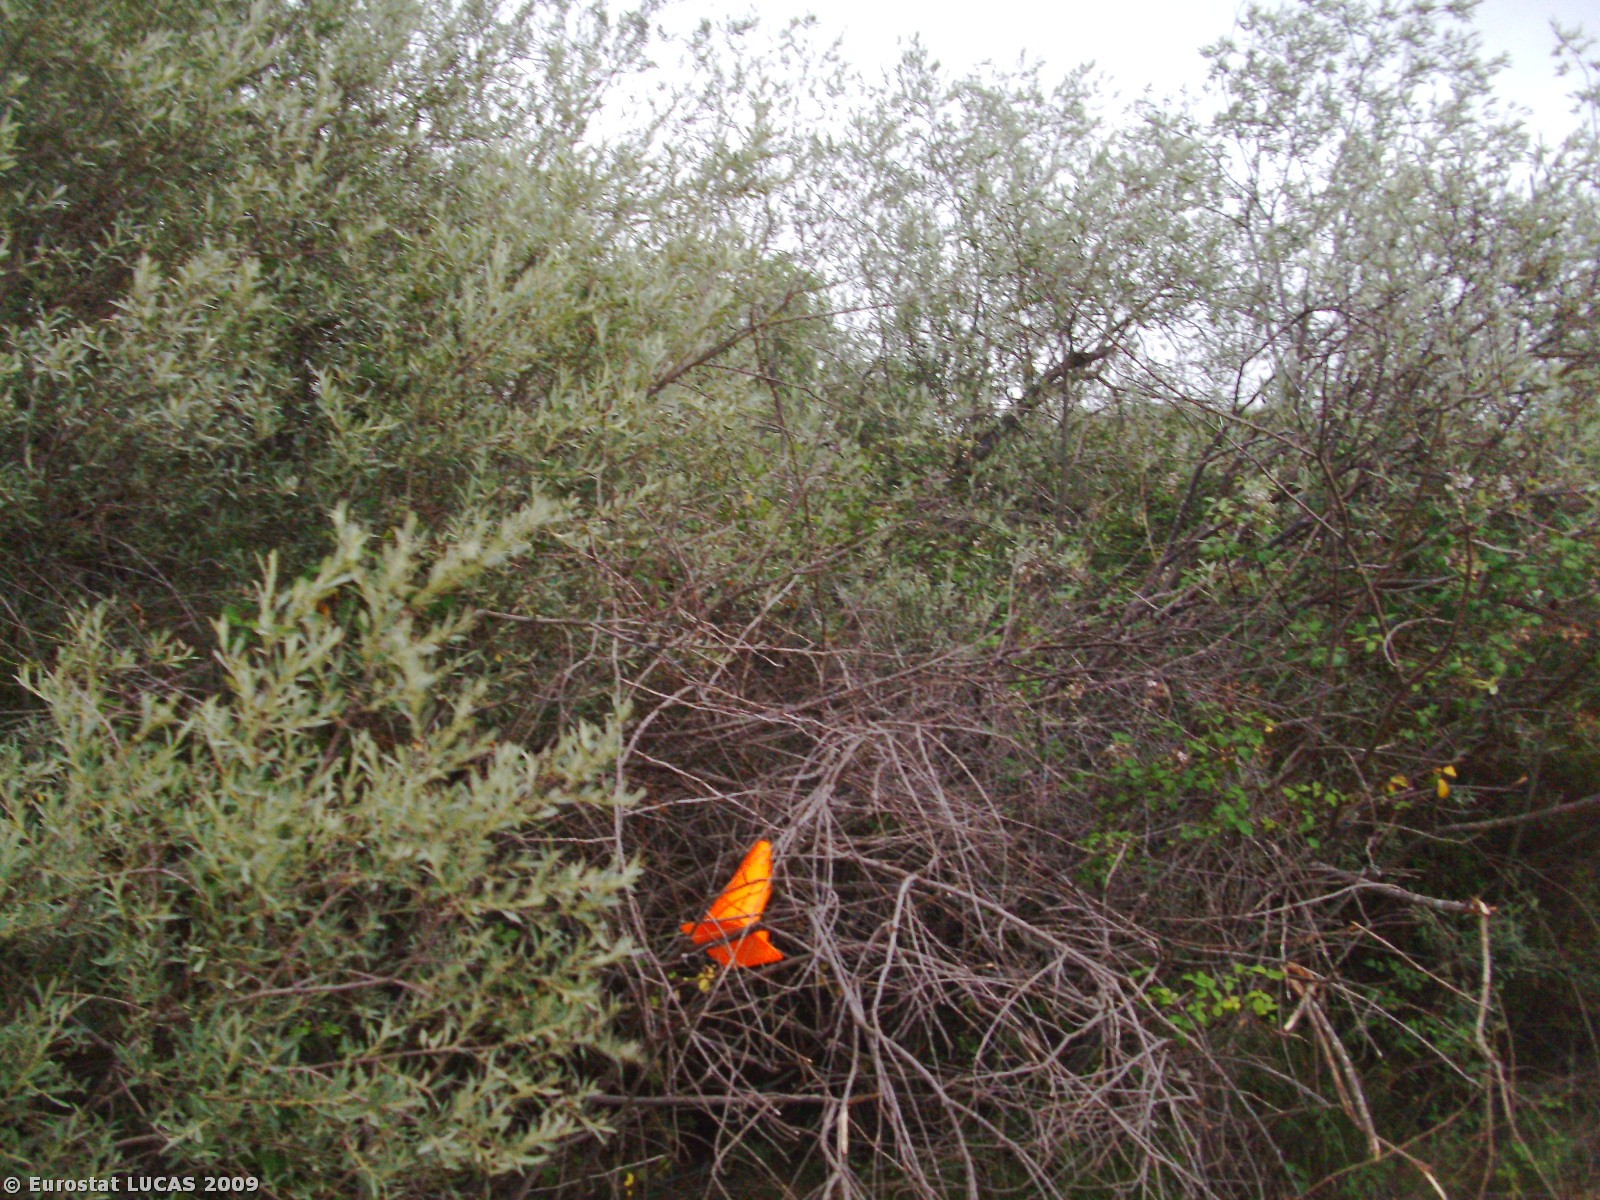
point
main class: Woodland
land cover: Broadleaved woodland
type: mesophytic deciduous forest
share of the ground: > 75 %
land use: Forestry
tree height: > 5 m
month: June
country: PT
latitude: 39.7896
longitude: -7.3904
